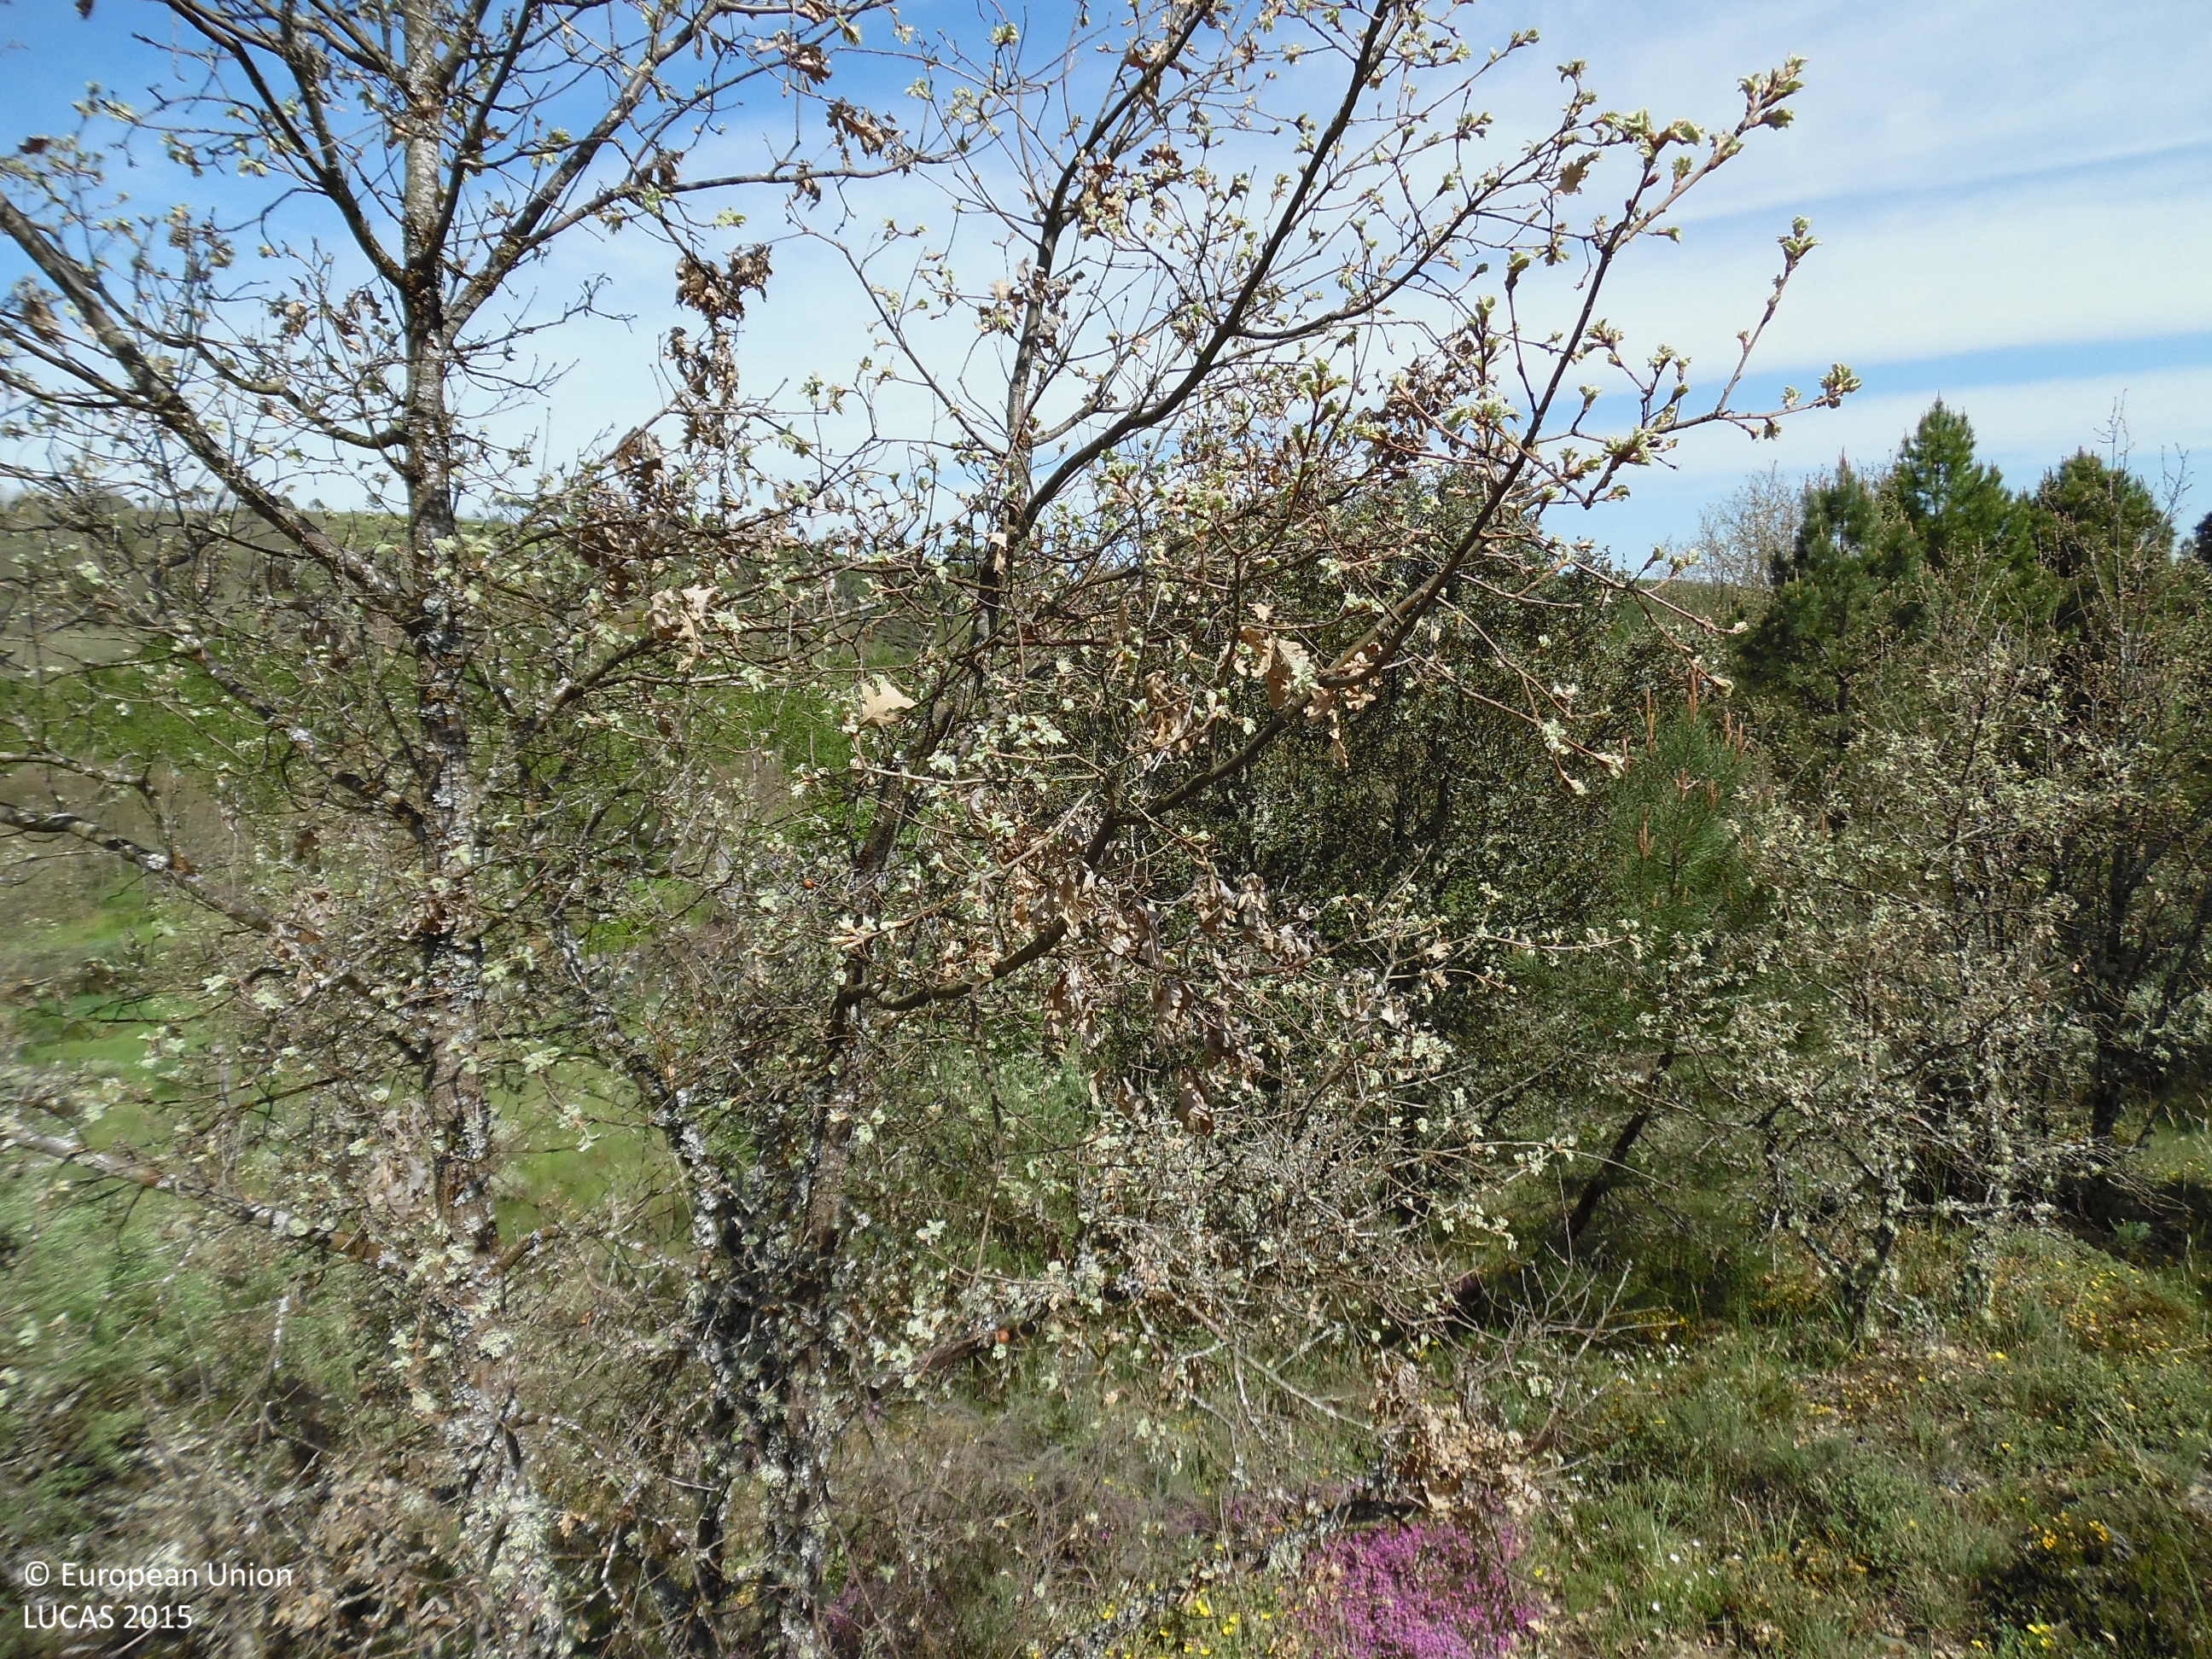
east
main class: Shrubland
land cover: Shrubland with sparse tree cover
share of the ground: > 75 %
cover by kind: shrubs 95 %, broadleaved forest trees 5 %
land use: Forestry
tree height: < 5 m
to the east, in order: Shrubland with sparse tree cover; Grassland with sparse tree/shrub cover; Rock outcrops; Grass margins; Tracks; Single bushes/trees; Artificial constructions in urban areas; Grassland without tree/shrub cover; Grassland with sparse tree/shrub cover; Broadleaved woodland; Dry stone walls; Abandoned hedges; Grassland without tree/shrub cover; Groves; Rivers and streams; Groves; Grassland without tree/shrub cover; Paved roads, cycling and walking lanes; Grass margins; Broadleaved woodland; Electric lines; Broadleaved woodland; Inland fresh running water; Broadleaved woodland
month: May
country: ES
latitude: 42.5724
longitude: -6.0792
